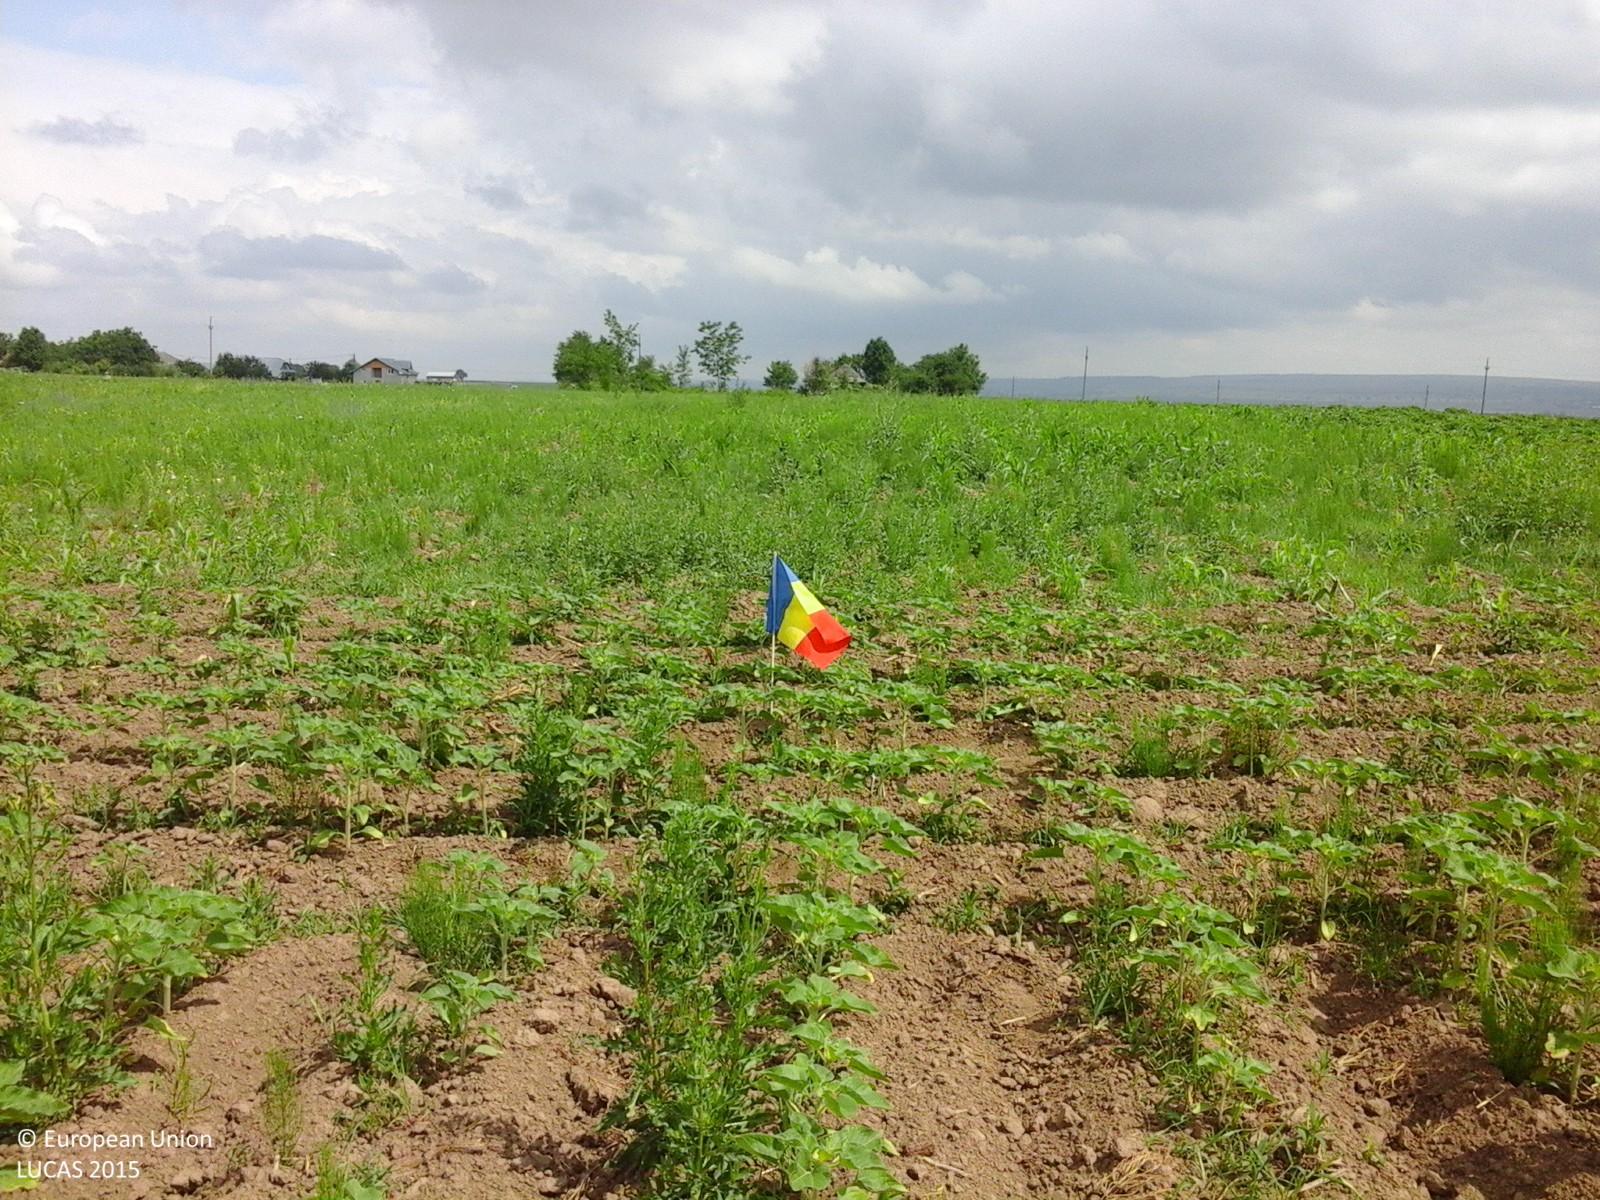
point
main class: Cropland
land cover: Sunflower
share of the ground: 25 - 50 %
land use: Agriculture (excluding fallow land and kitchen gardens)
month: June
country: RO
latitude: 47.0789
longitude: 26.6183
